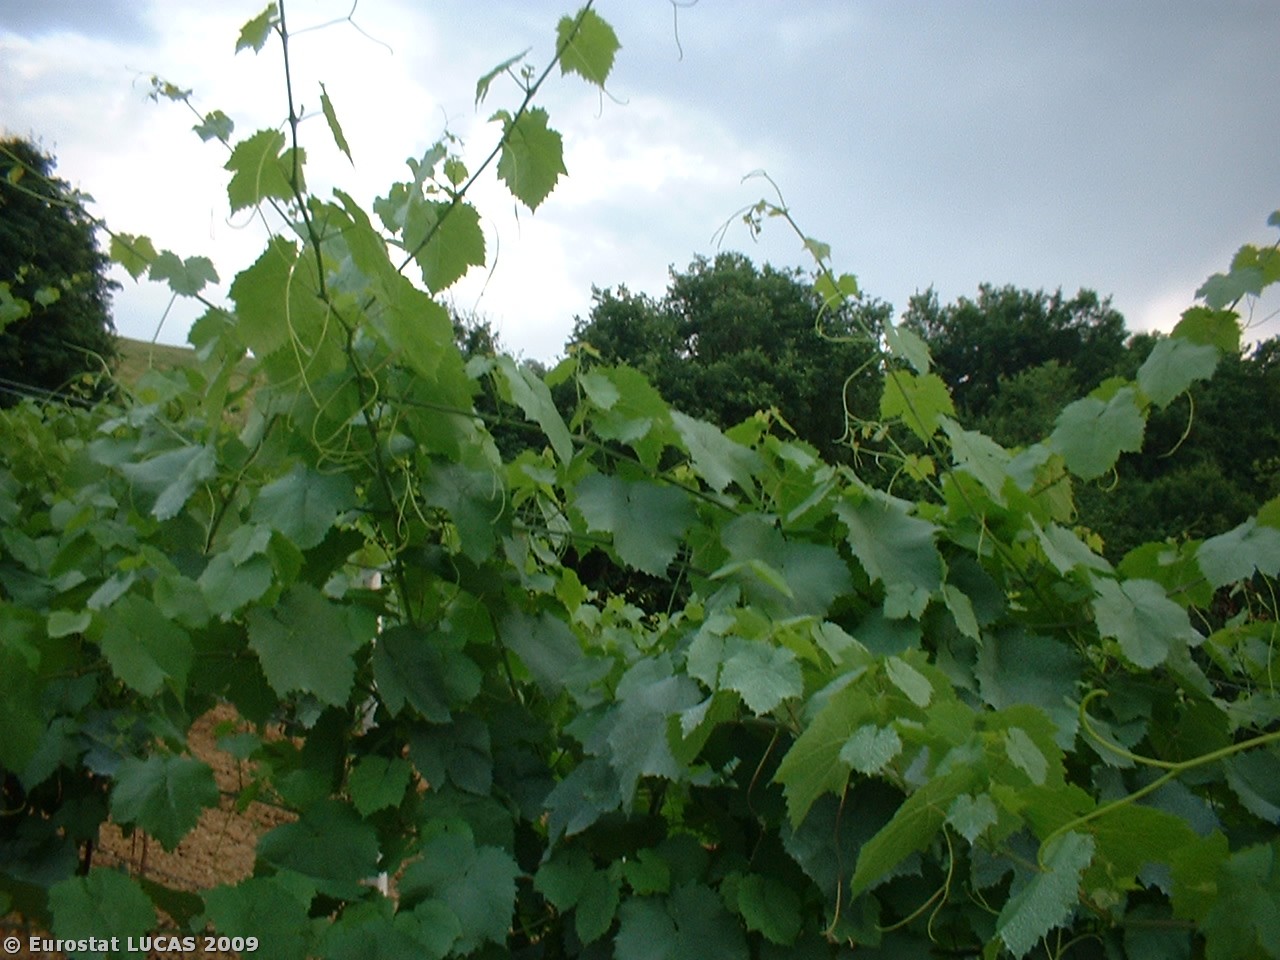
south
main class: Cropland
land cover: Vineyards
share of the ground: 25 - 50 %
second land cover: Bare land
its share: > 75 %
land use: Agriculture (excluding fallow land and kitchen gardens)
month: June
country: IT
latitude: 42.8928
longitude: 13.7246
